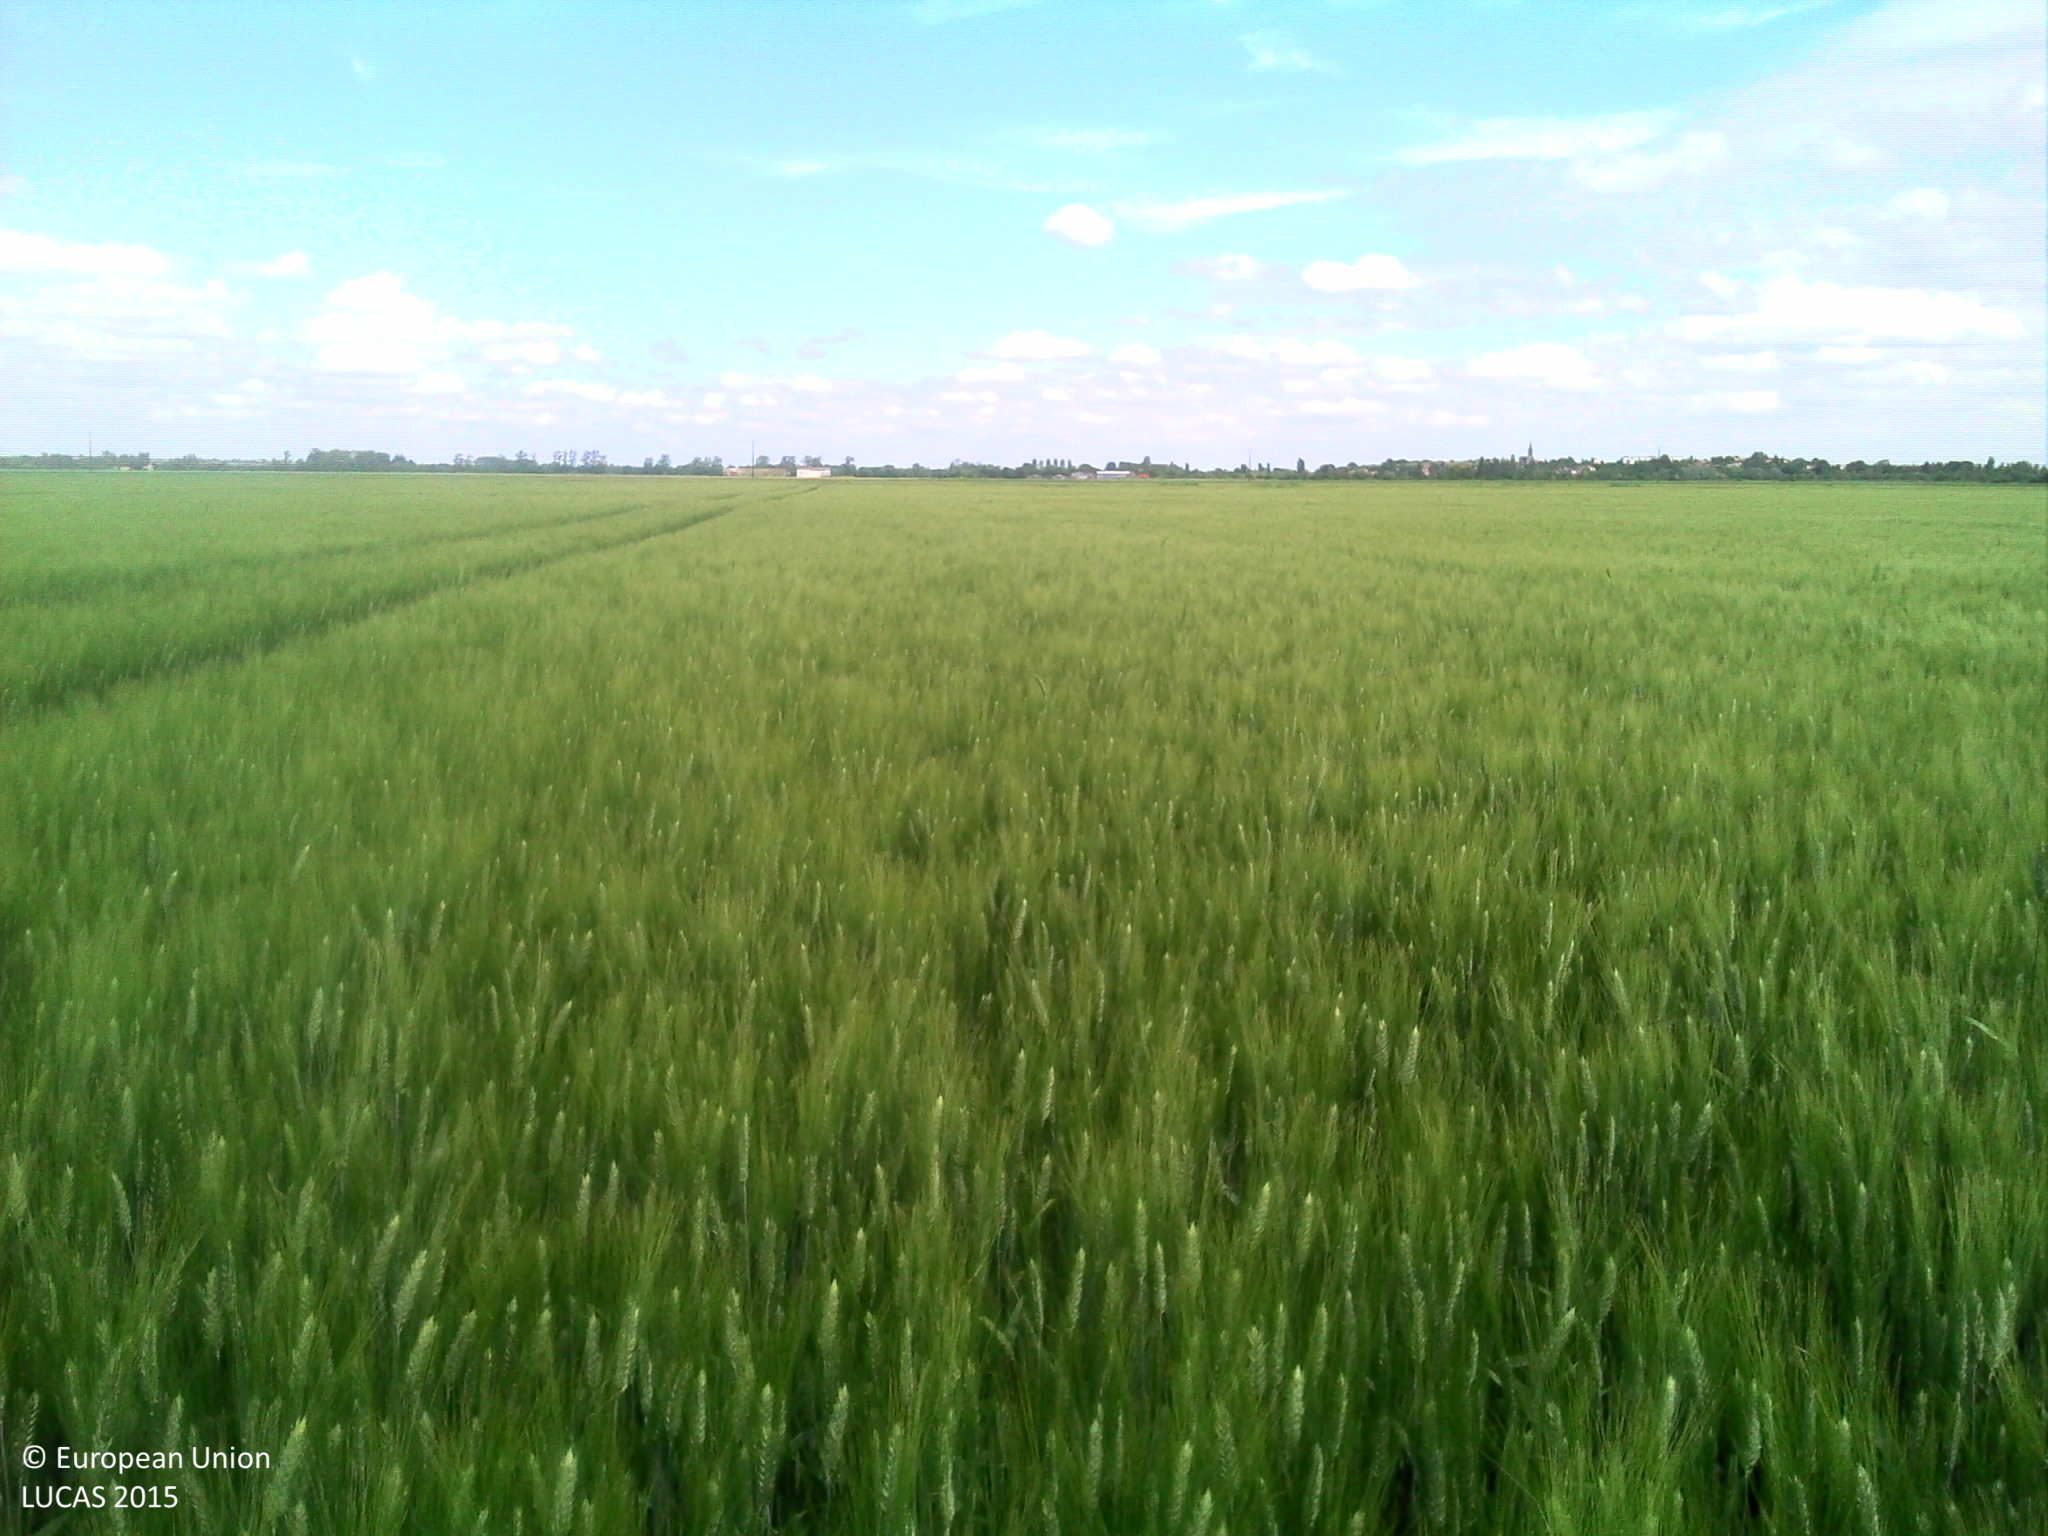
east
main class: Cropland
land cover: Durum wheat
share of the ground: > 75 %
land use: Agriculture (excluding fallow land and kitchen gardens)
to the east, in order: Durum wheat; Shruby margins; Ditches and canals; Shruby margins; Durum wheat
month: June
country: FR
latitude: 46.3291
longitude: -0.9811
